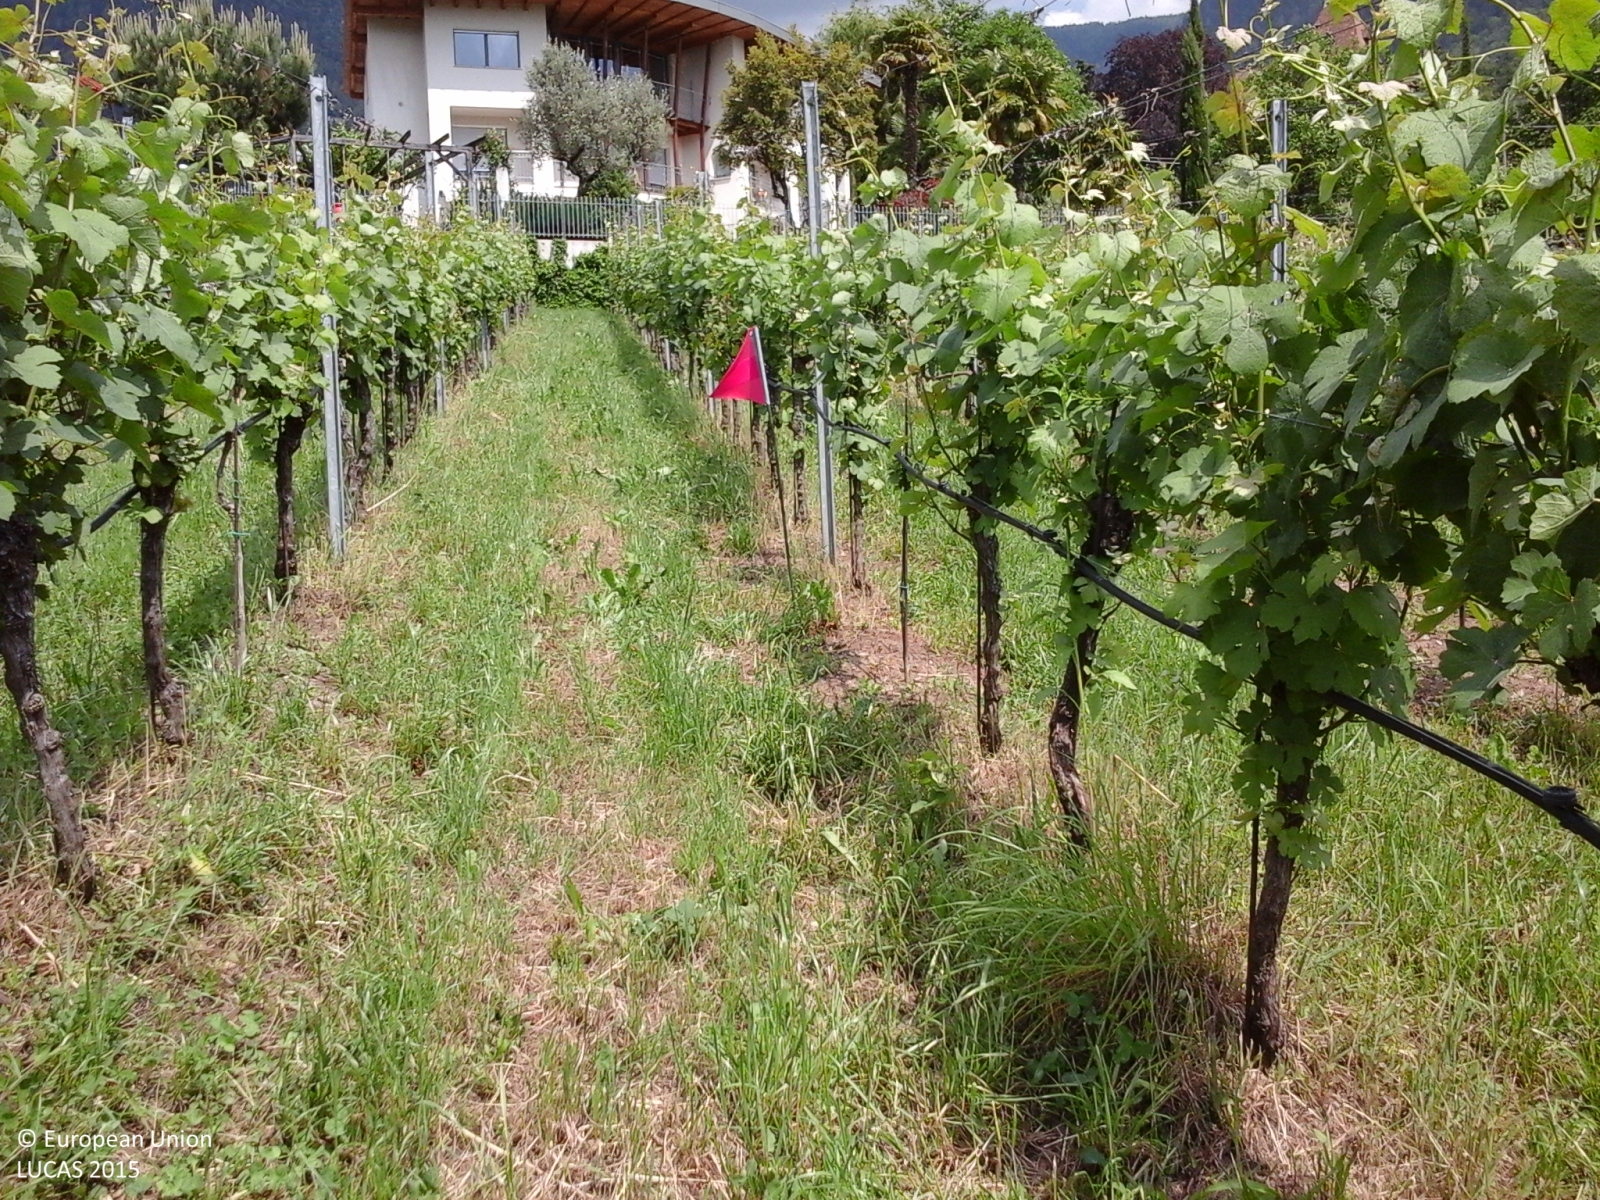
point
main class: Cropland
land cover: Vineyards
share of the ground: 50 - 75 %
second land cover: Grassland without tree/shrub cover
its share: > 75 %
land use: Agriculture (excluding fallow land and kitchen gardens)
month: May
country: IT
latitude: 46.6688
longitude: 11.1881
